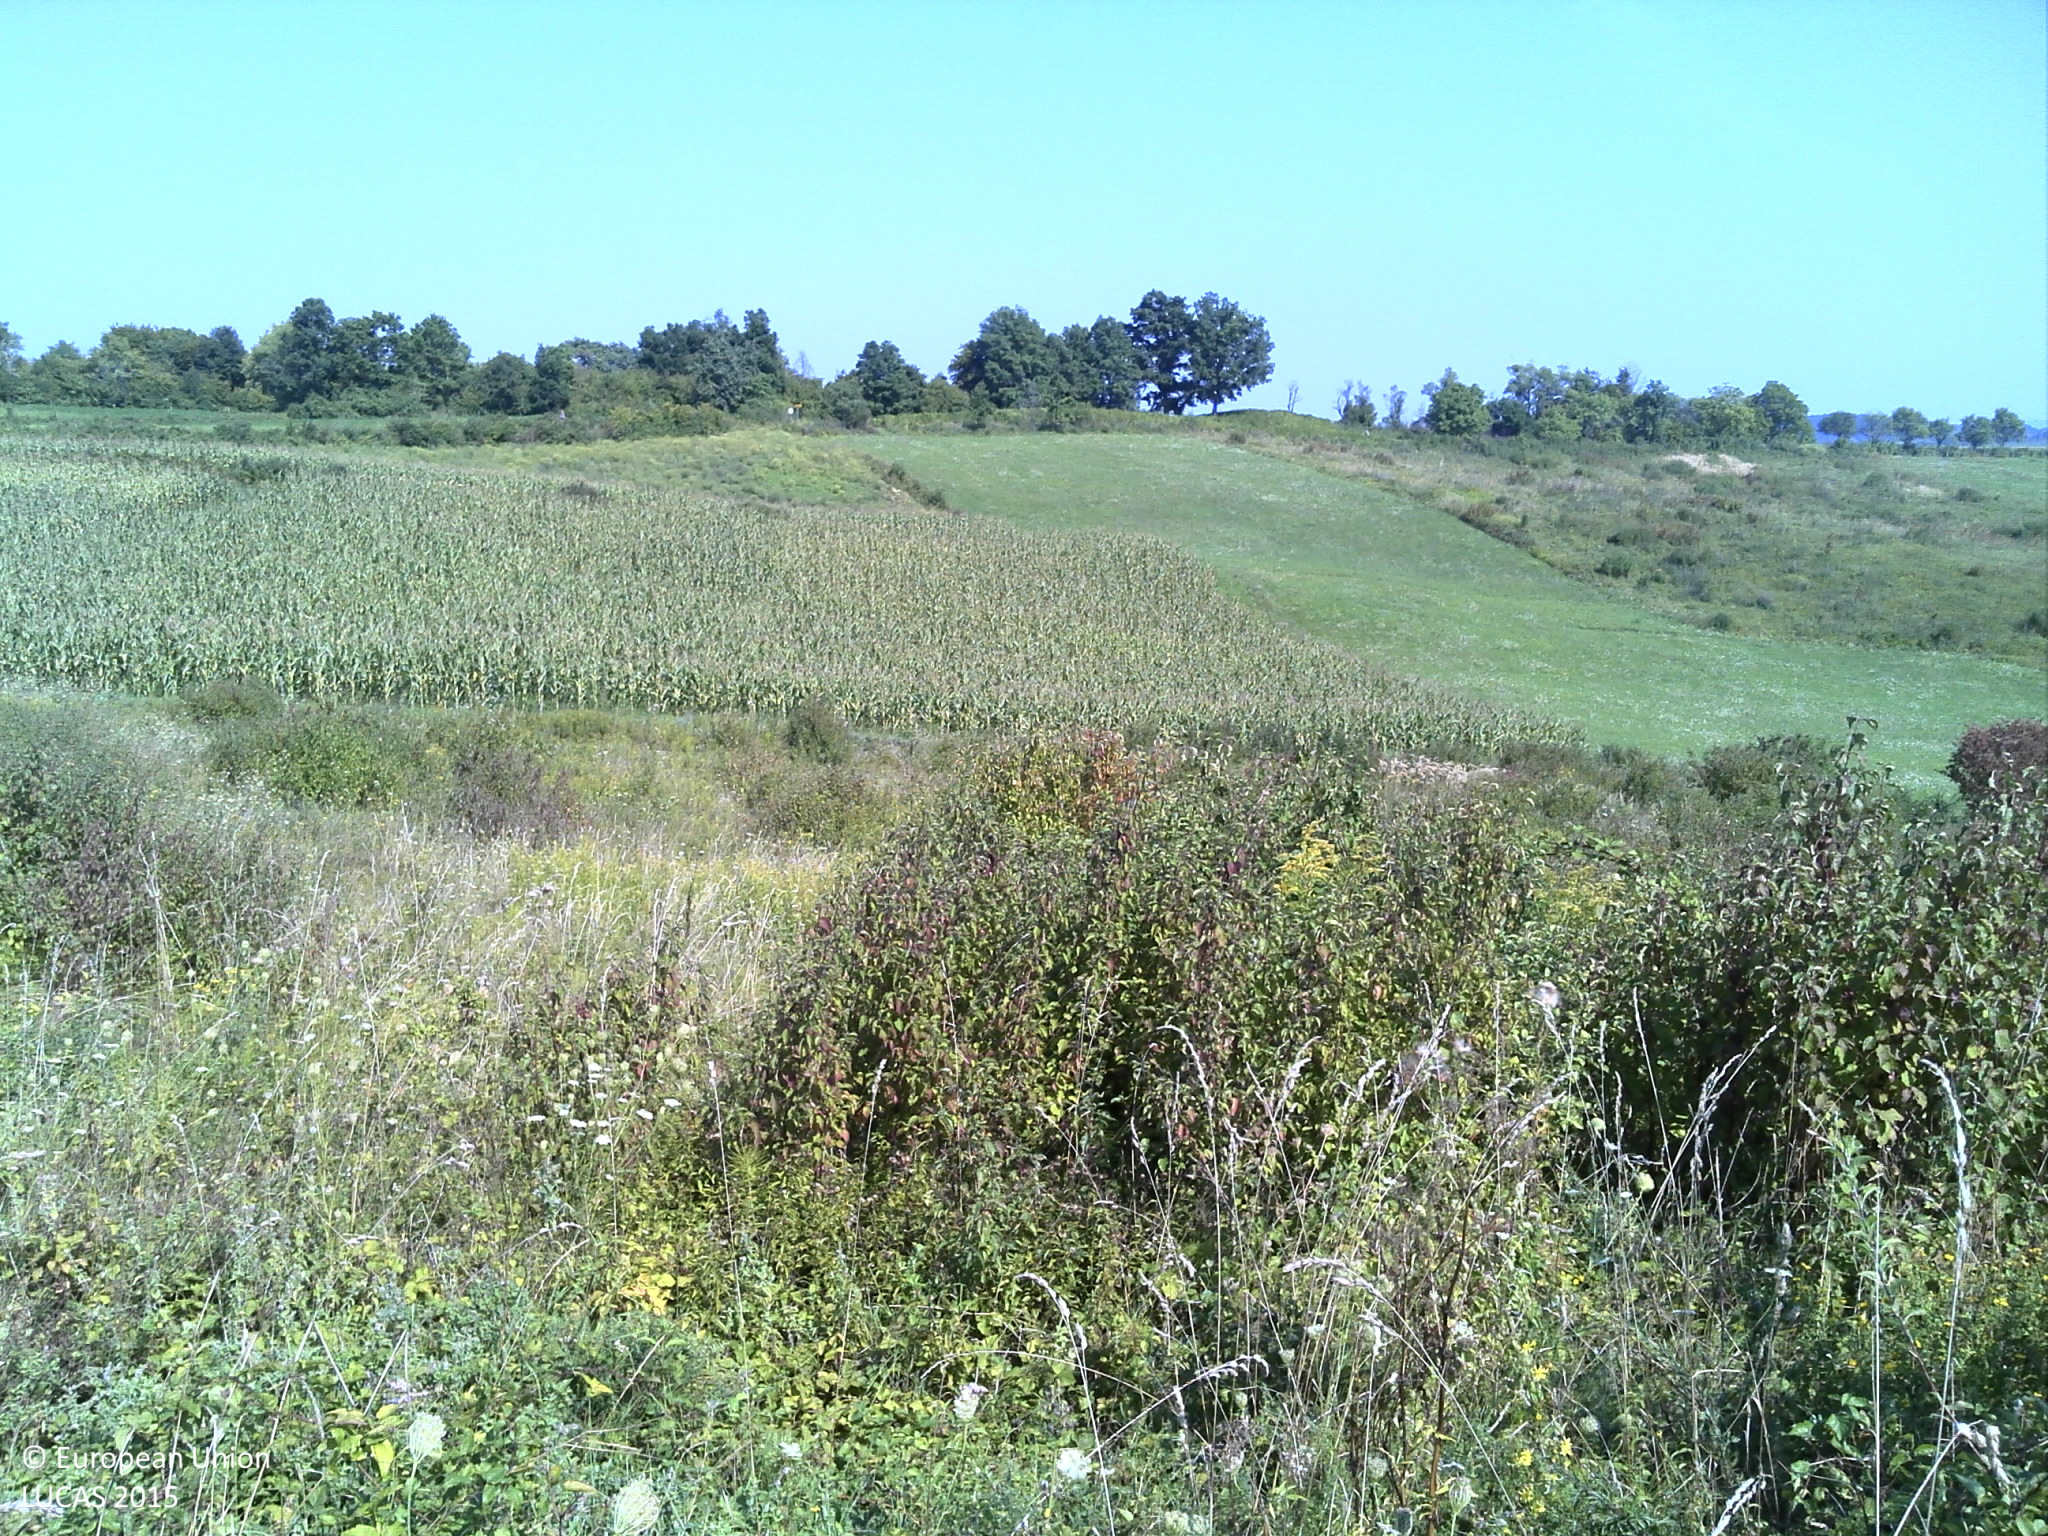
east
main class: Grassland
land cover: Spontaneously vegetated surfaces
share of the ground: > 75 %
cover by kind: herbaceous plants 100 %
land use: Semi-natural and natural areas not in use
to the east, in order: Spontaneously vegetated surfaces; Fences; Maize; Spontaneously vegetated surfaces; Paved roads, cycling and walking lanes; Shrubland without tree cover
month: August
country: HR
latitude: 45.1853
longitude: 16.3731
